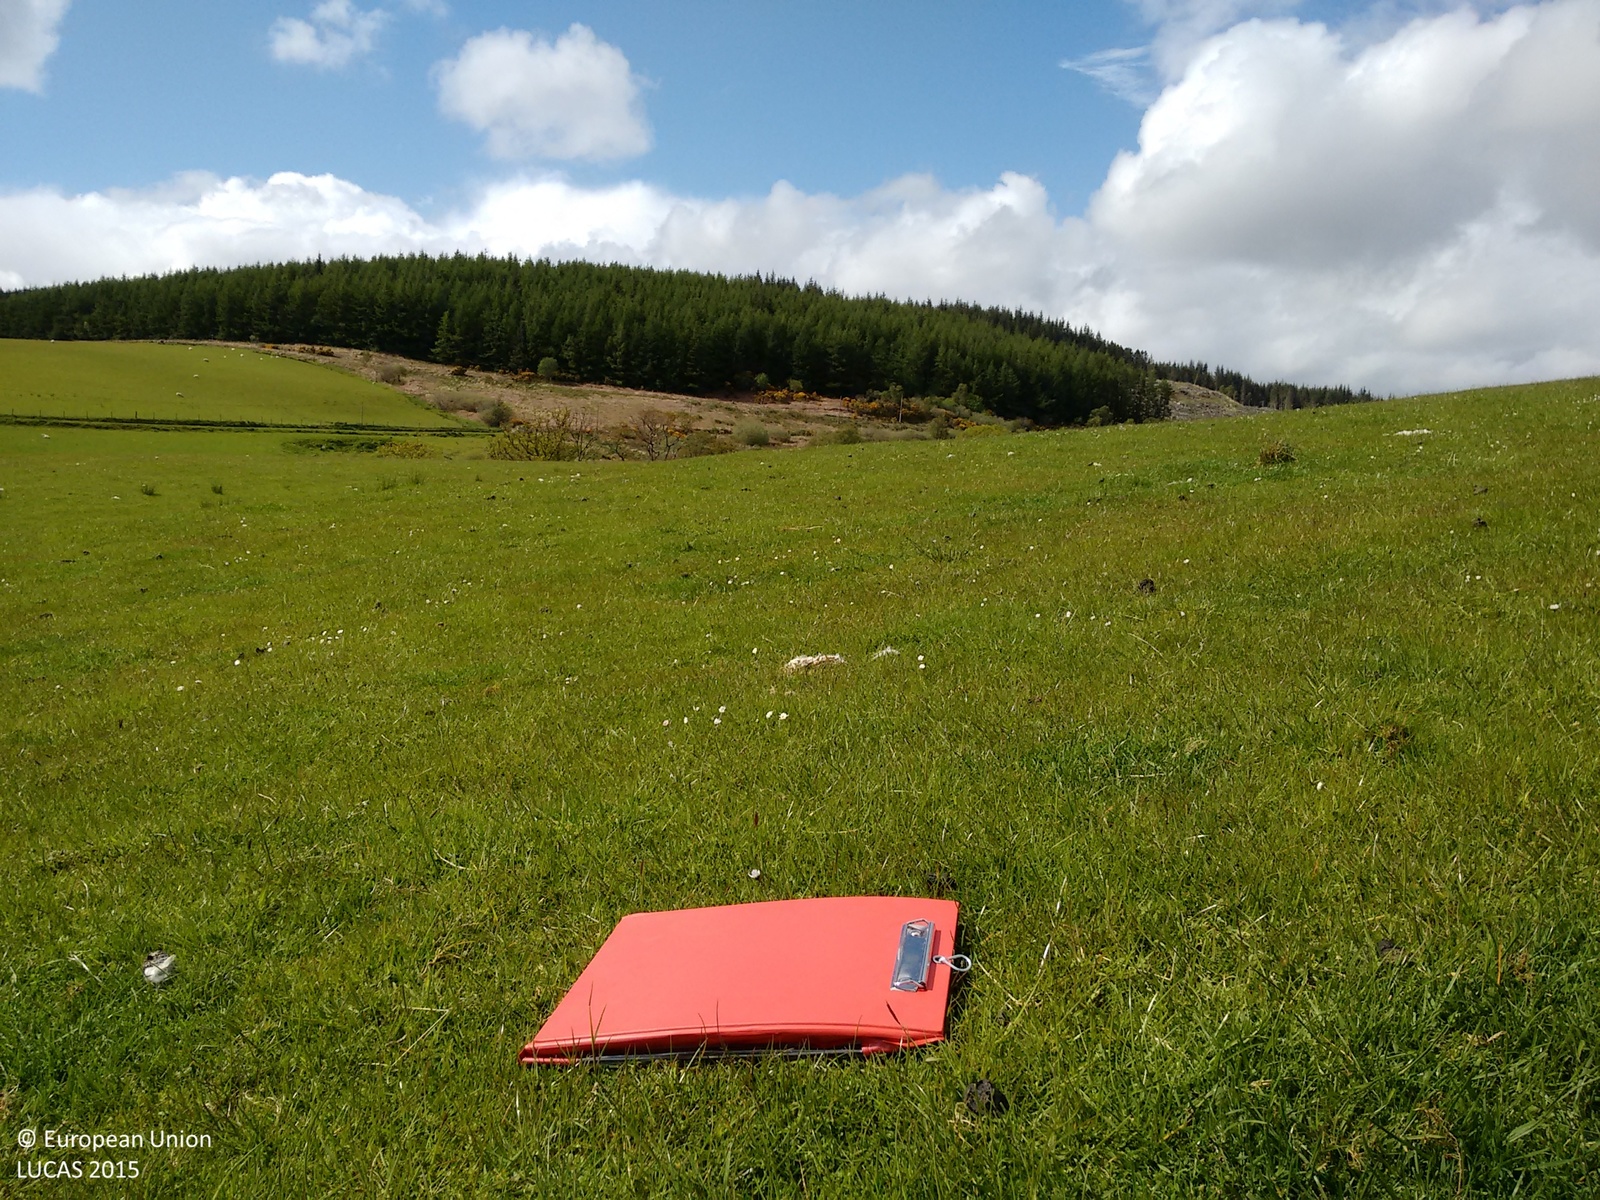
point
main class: Grassland
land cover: Grassland without tree/shrub cover
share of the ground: > 75 %
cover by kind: herbaceous plants 100 %
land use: Agriculture (excluding fallow land and kitchen gardens)
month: May
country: GB
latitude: 55.8695
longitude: -5.2832
